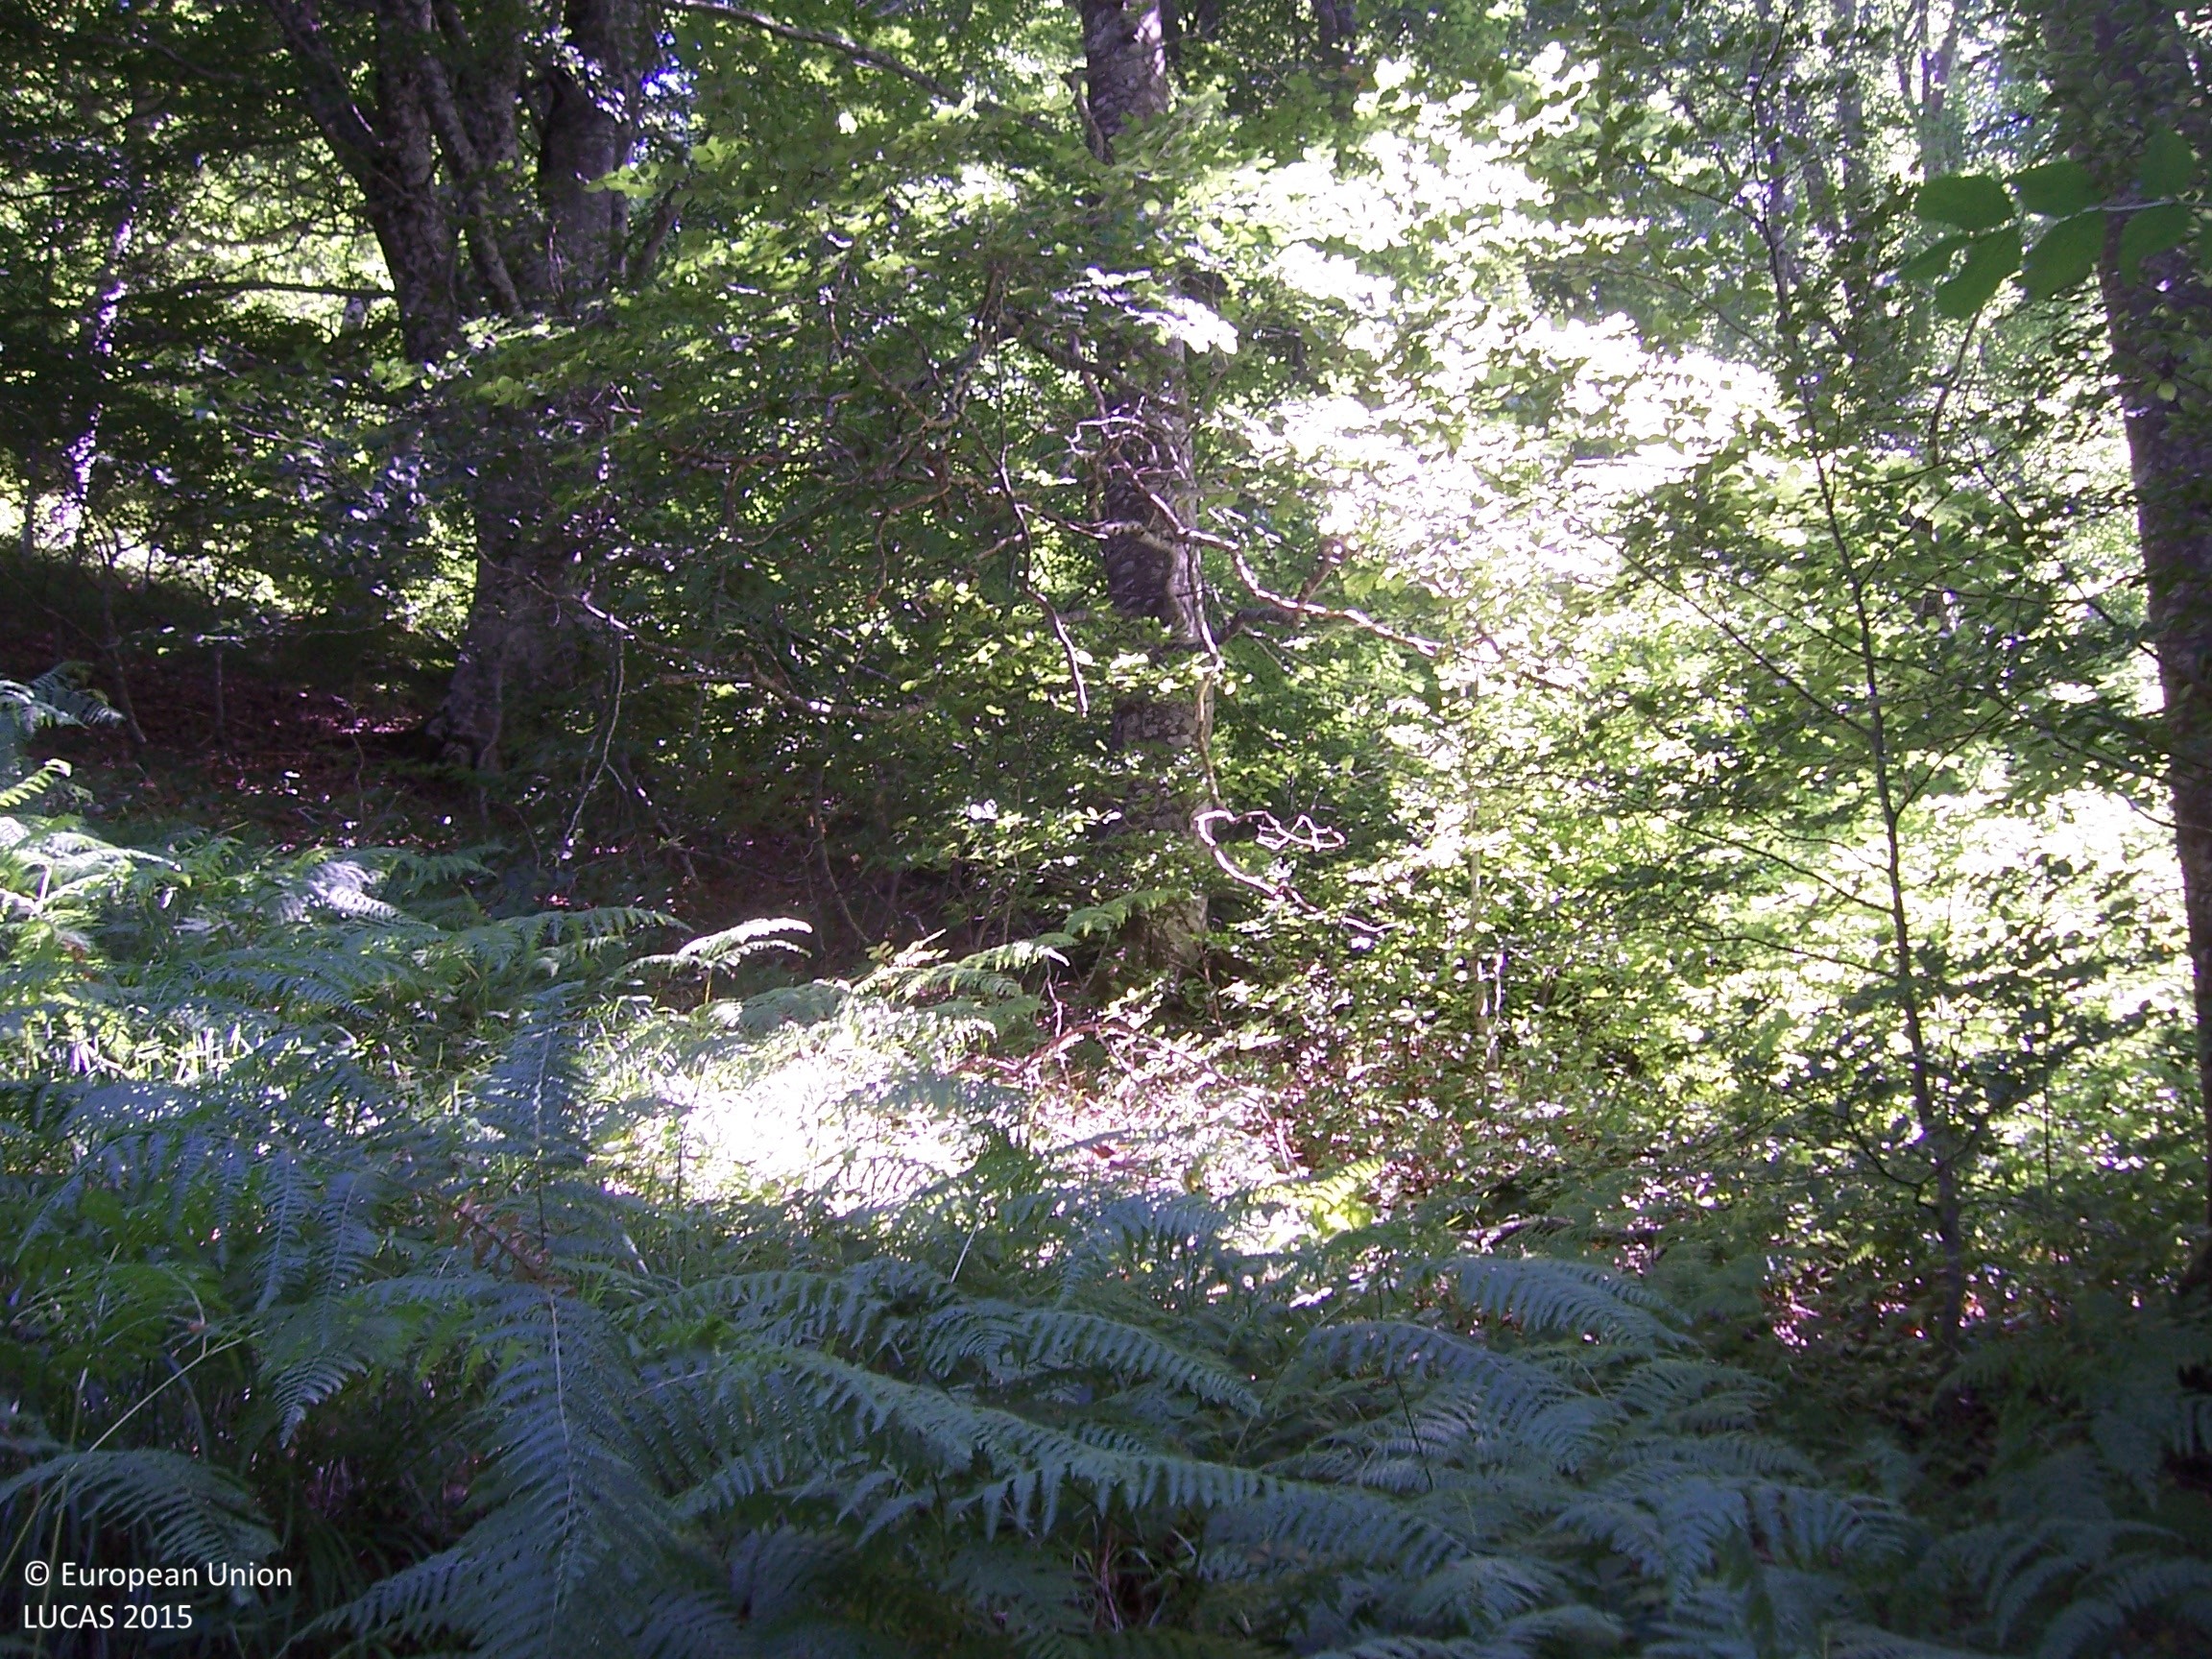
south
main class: Woodland
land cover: Broadleaved woodland
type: mountainous beech forest
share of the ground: > 75 %
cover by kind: broadleaved forest trees 100 %
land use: Forestry
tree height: > 5 m
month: July
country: ES
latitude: 42.9236
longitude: -1.1968
